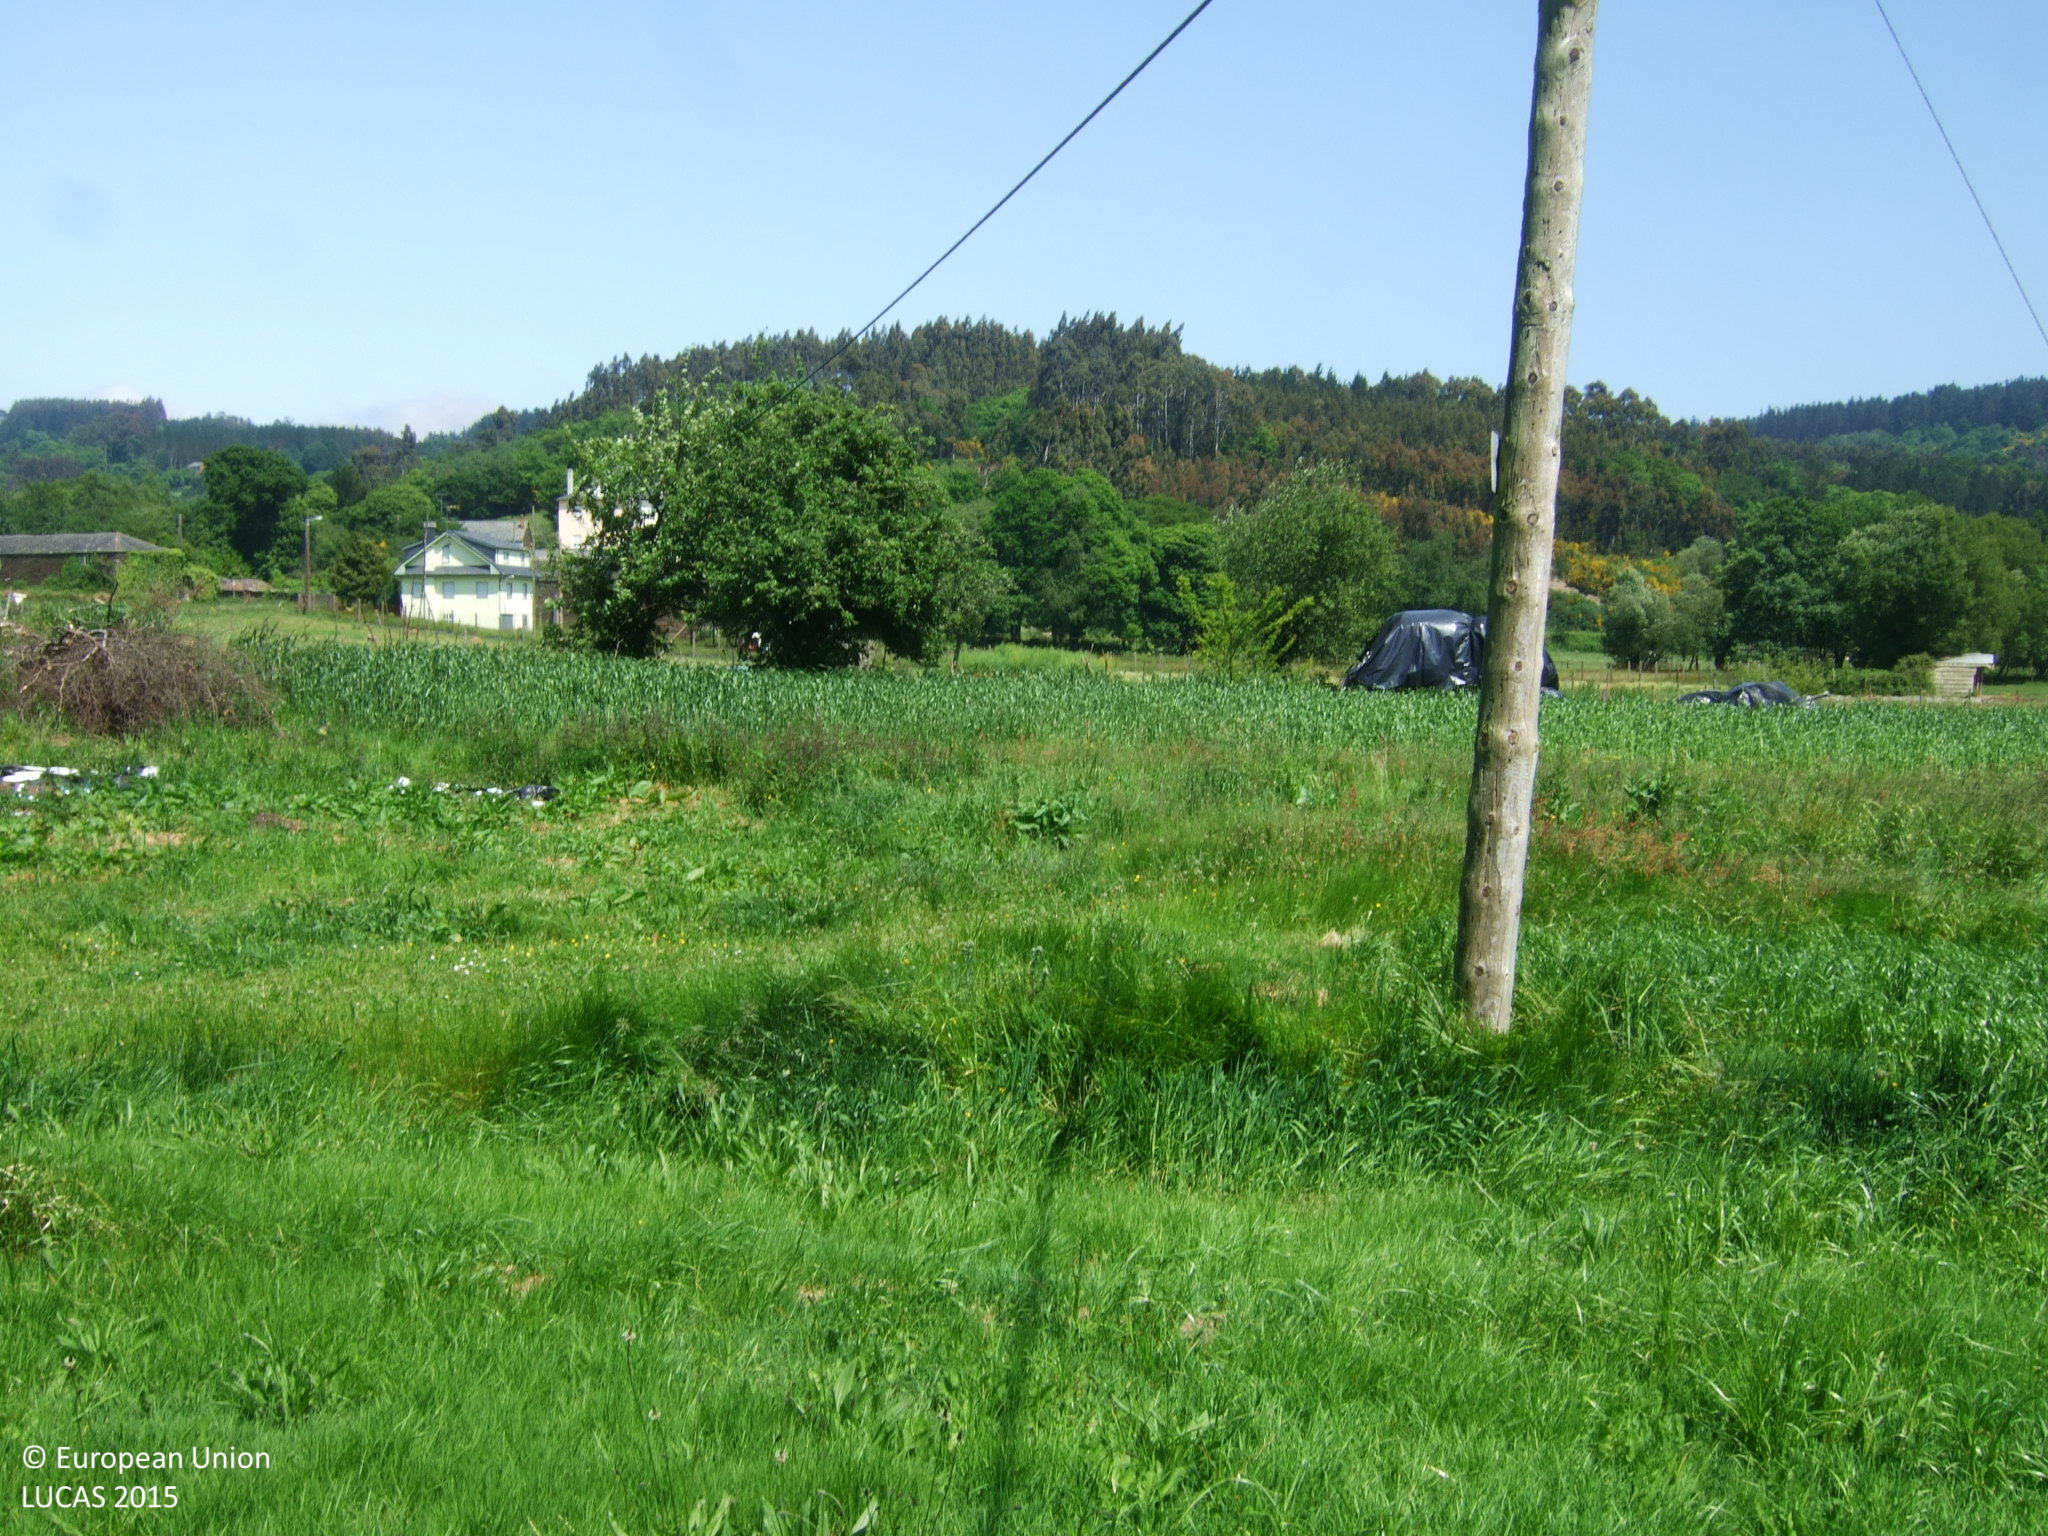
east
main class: Grassland
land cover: Grassland without tree/shrub cover
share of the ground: > 75 %
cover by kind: herbaceous plants 100 %
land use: Agriculture (excluding fallow land and kitchen gardens)
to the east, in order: Grassland without tree/shrub cover; Durum wheat; Electric lines; Fences; Other fresh vegetables; Fences; Grassland without tree/shrub cover; Other bare soil; Fences; Grassland without tree/shrub cover; Fences; Grassland without tree/shrub cover; Fences; Grassland without tree/shrub cover; Fences; Grassland without tree/shrub cover; Groves; Artificial constructions in urban areas
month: June
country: ES
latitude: 43.3098
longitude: -7.5000
